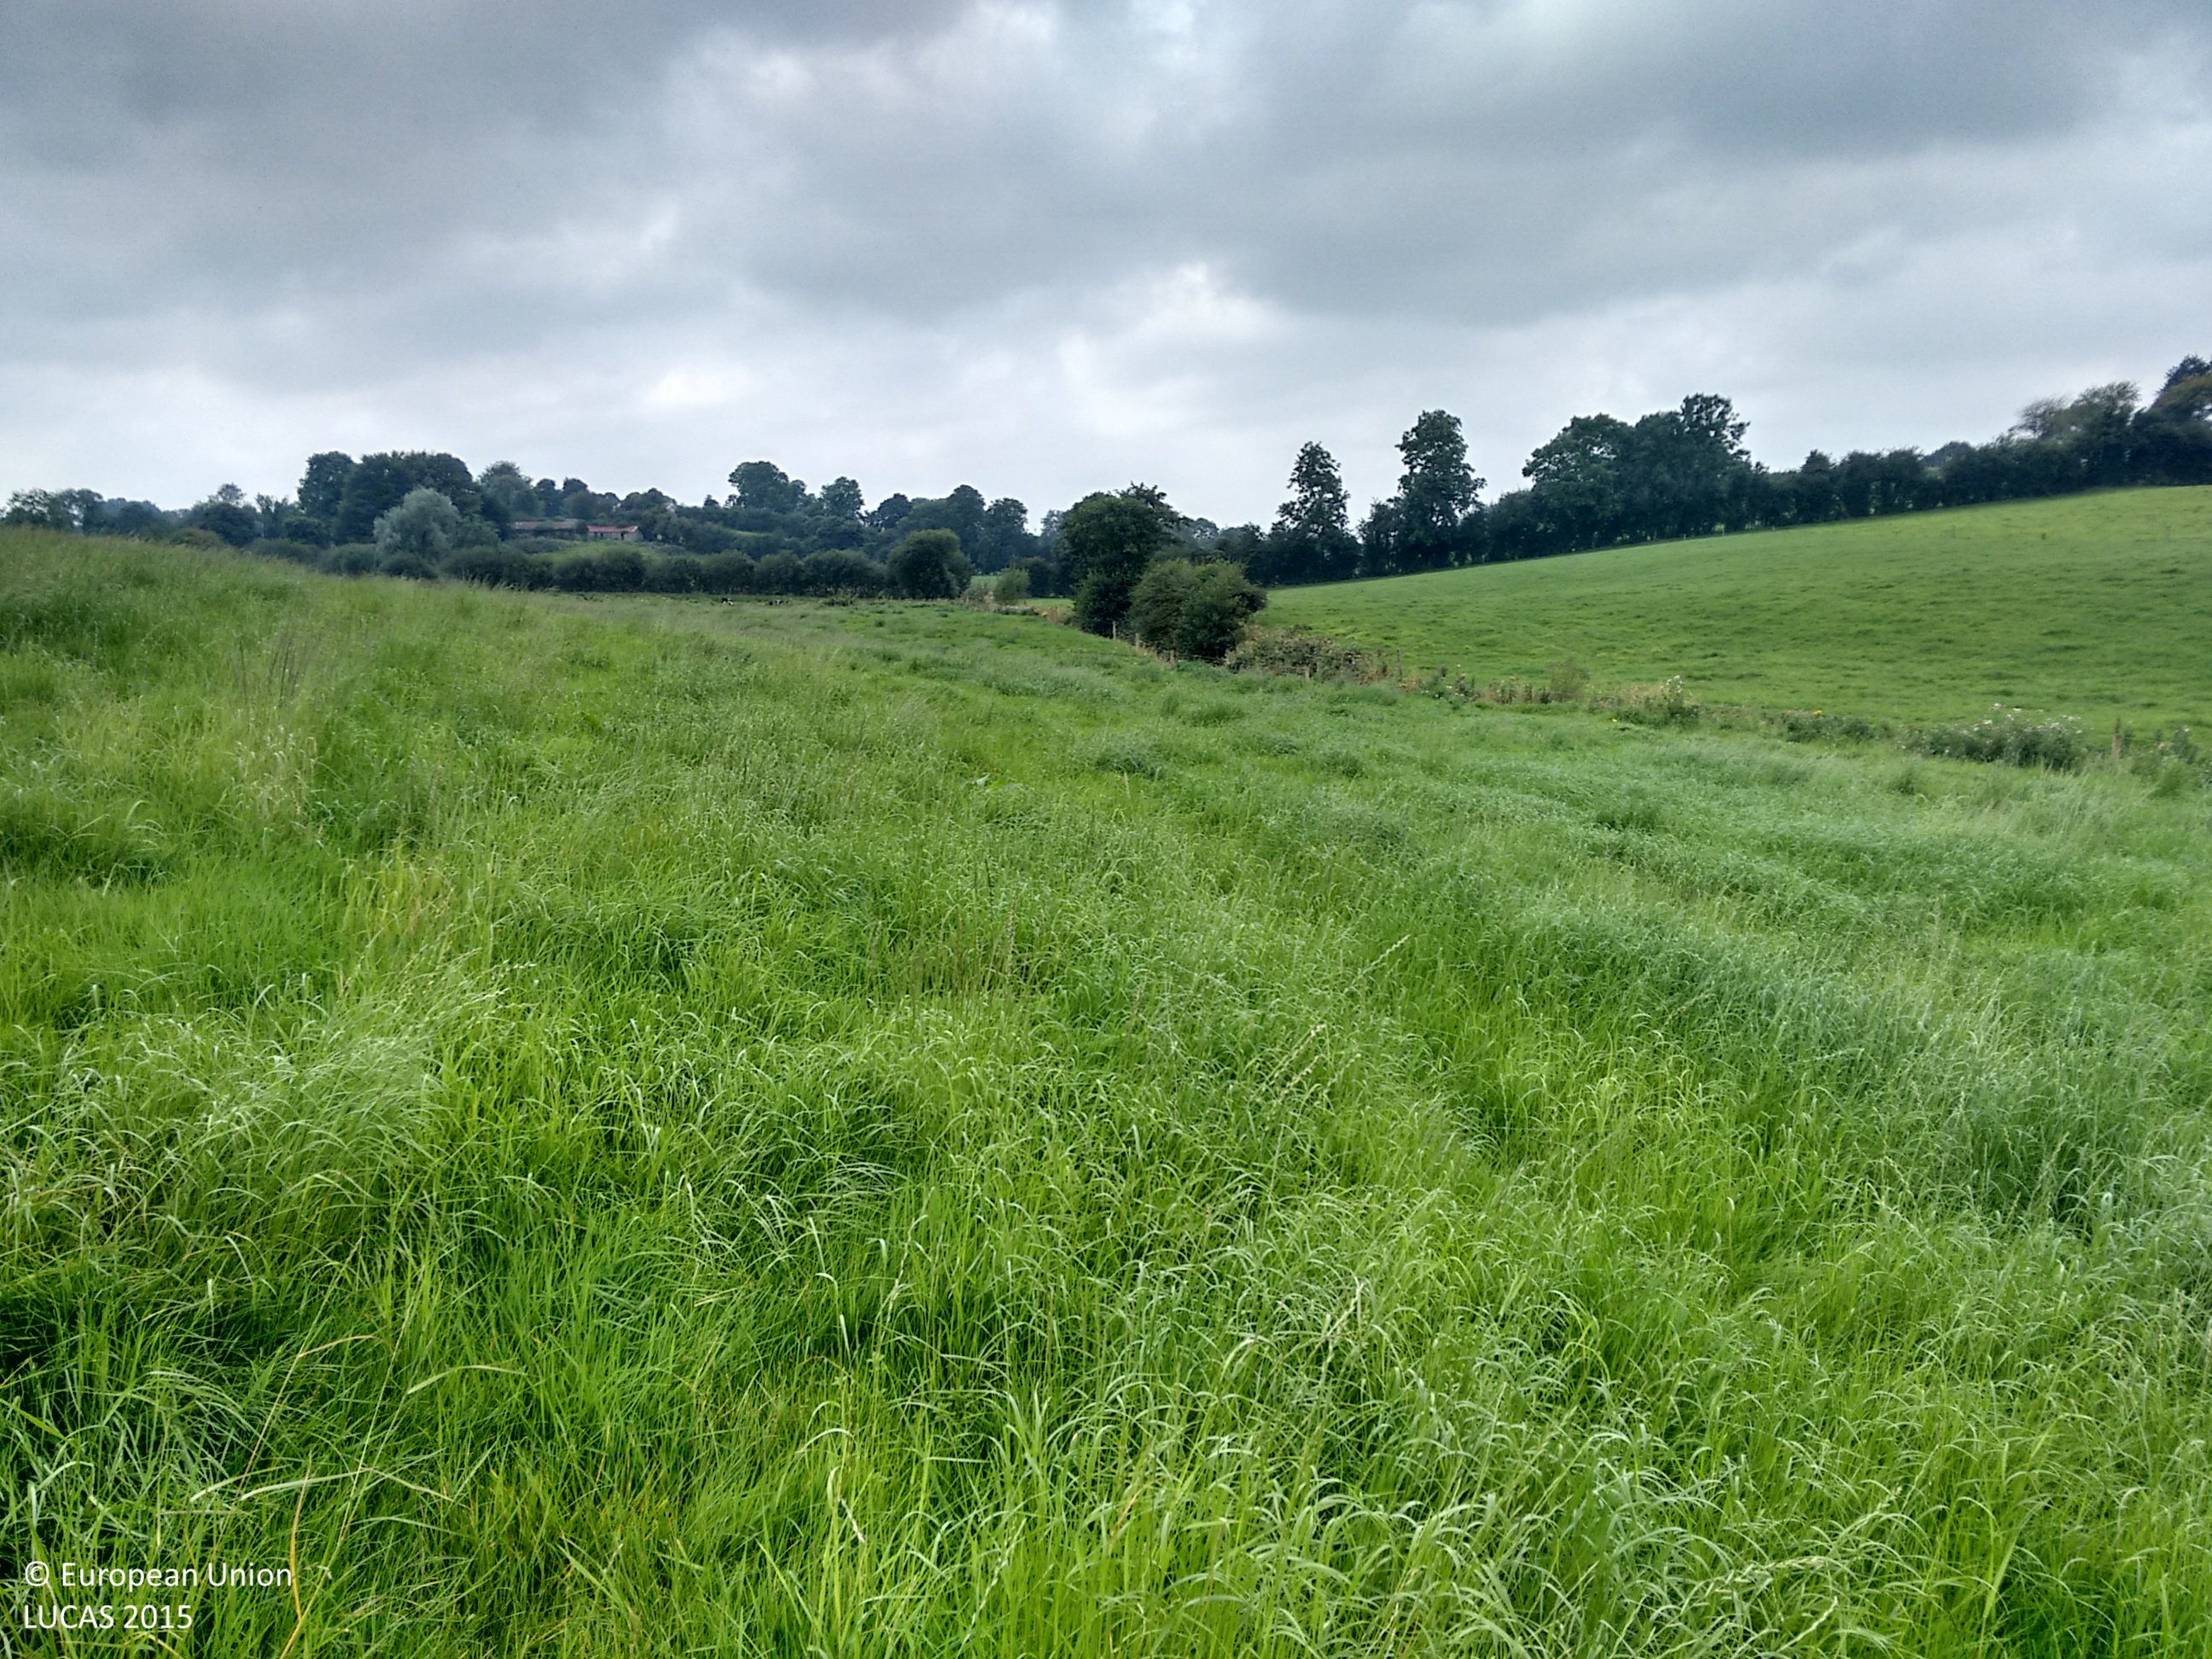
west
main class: Grassland
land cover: Grassland without tree/shrub cover
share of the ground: > 75 %
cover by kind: herbaceous plants 100 %
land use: Agriculture (excluding fallow land and kitchen gardens)
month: September
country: IE
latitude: 54.2738
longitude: -7.0811
